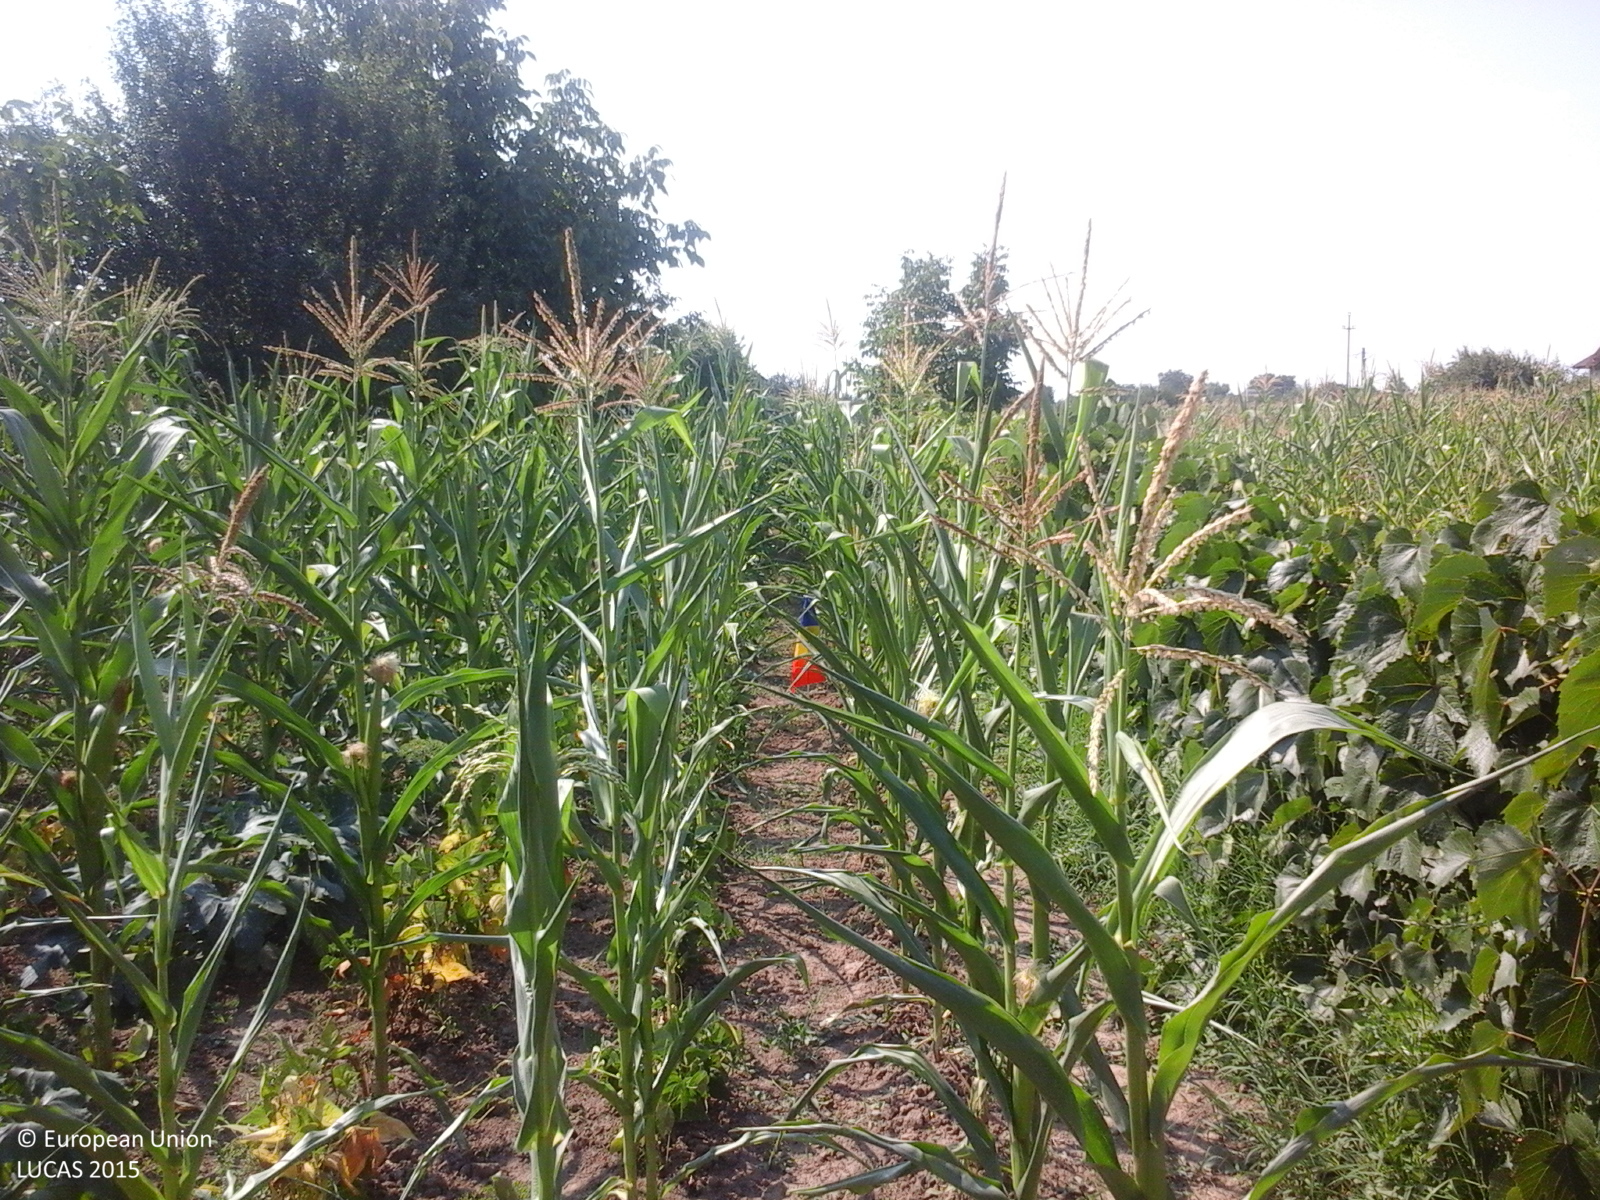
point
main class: Cropland
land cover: Maize
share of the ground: > 75 %
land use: Agriculture (excluding fallow land and kitchen gardens)
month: July
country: RO
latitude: 44.5997
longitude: 25.9133
